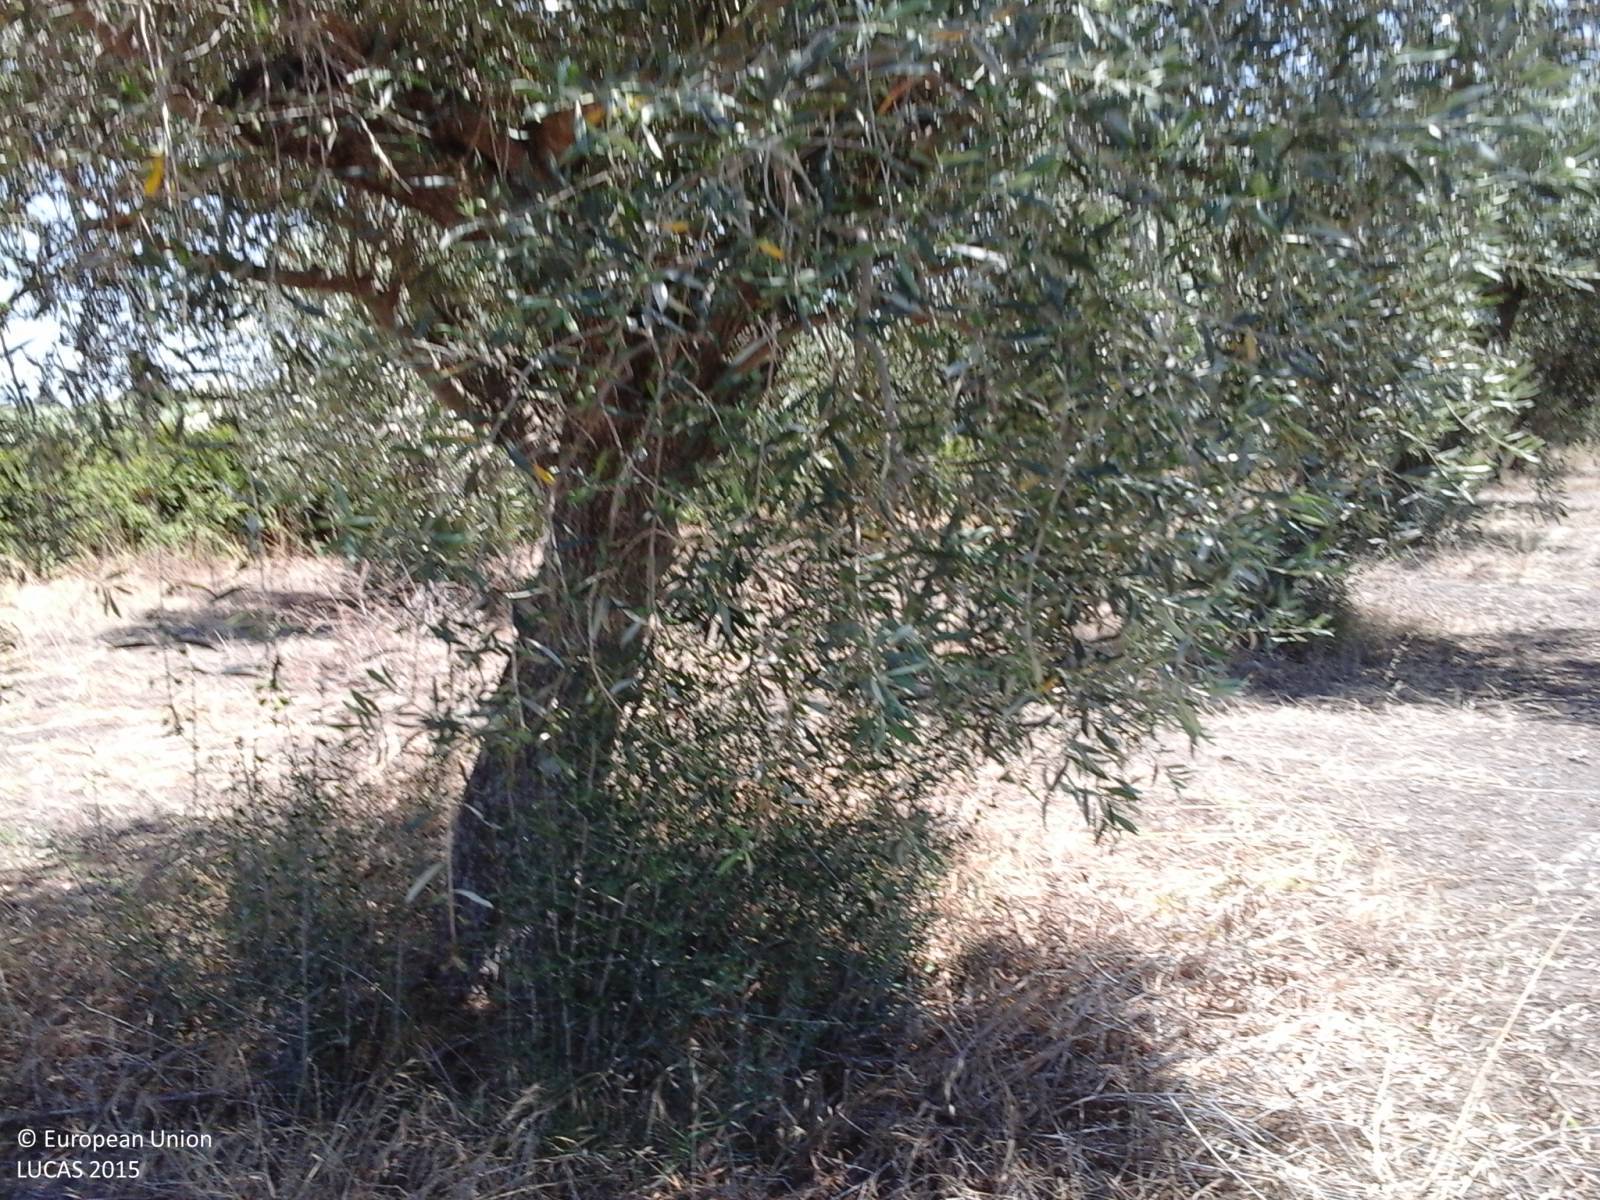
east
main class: Cropland
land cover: Olive groves
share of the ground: 50 - 75 %
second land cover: Spontaneously vegetated surfaces
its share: 25 - 50 %
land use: Agriculture (excluding fallow land and kitchen gardens)
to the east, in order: Olive groves; Spontaneously vegetated surfaces; Abandoned hedges; Rice; Abandoned hedges; Vineyards; Olive groves; Fences; Ditches and canals; Tracks; Abandoned hedges; Olive groves
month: July
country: IT
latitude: 39.9672
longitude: 8.5678
